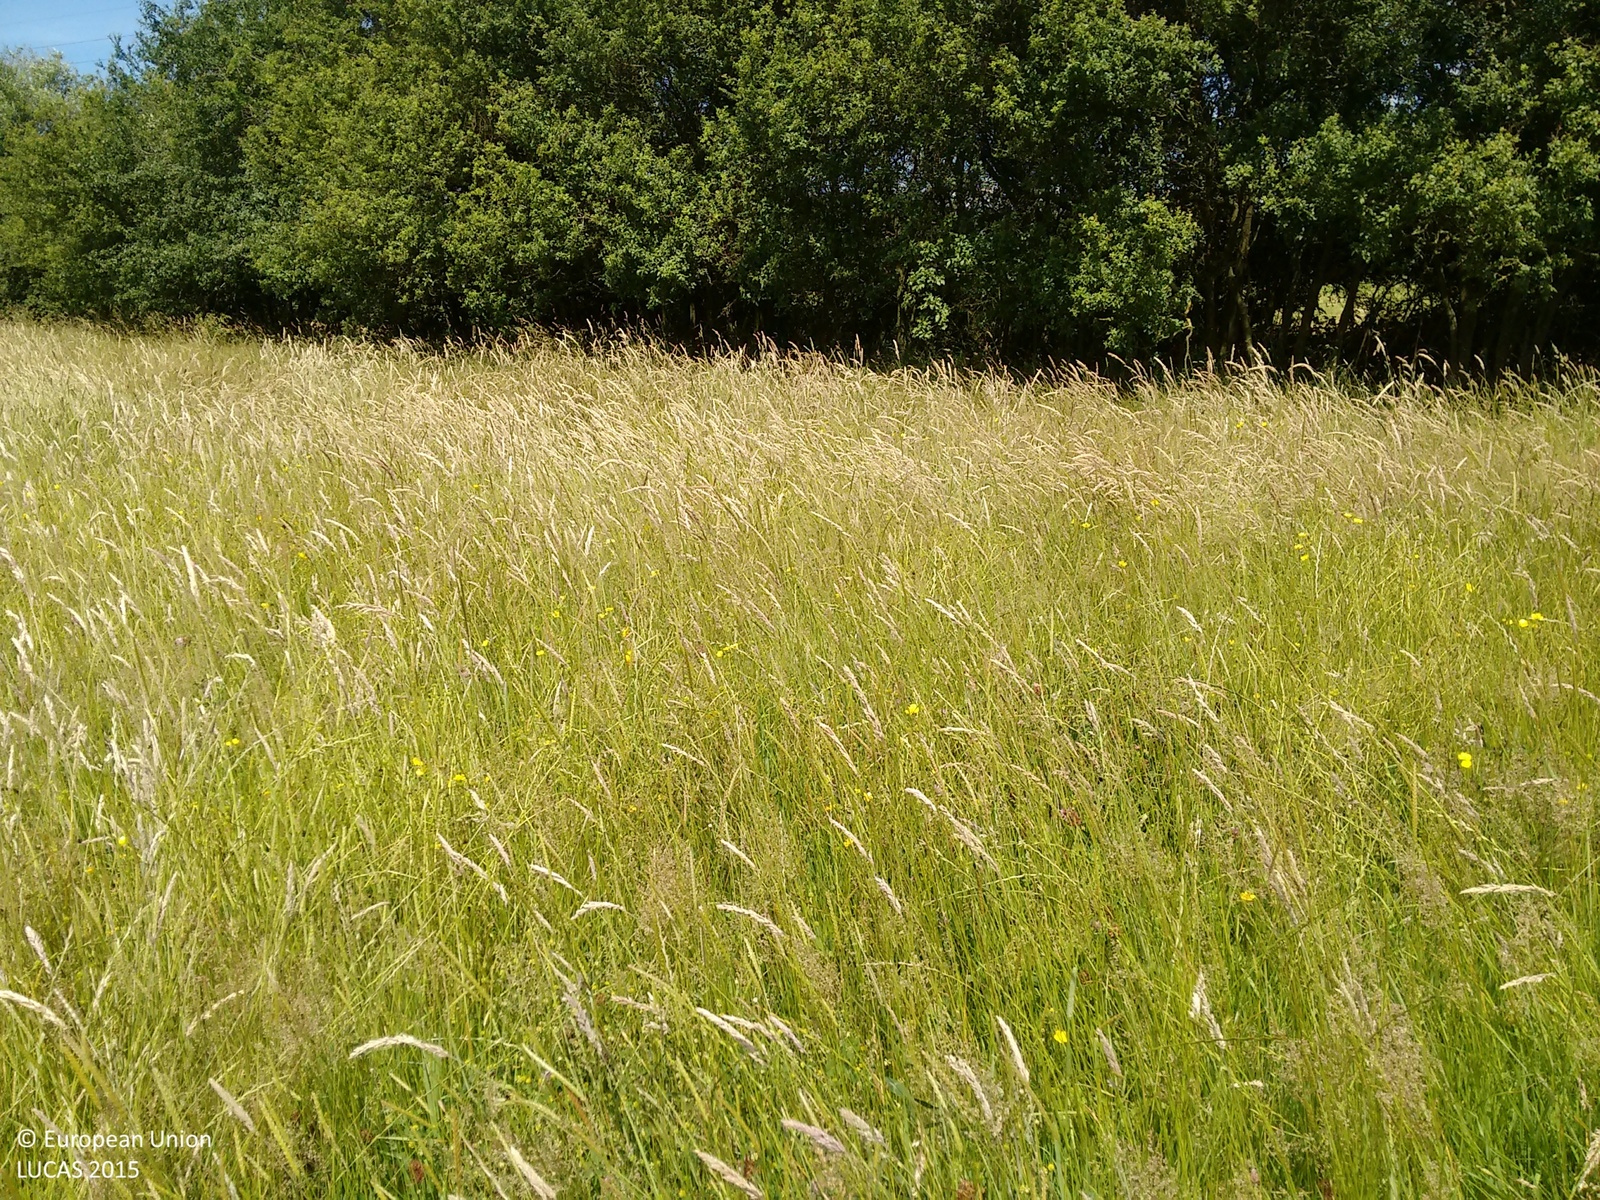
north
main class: Grassland
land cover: Grassland without tree/shrub cover
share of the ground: > 75 %
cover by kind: herbaceous plants 100 %
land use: Agriculture (excluding fallow land and kitchen gardens)
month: July
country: GB
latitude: 52.4417
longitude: -1.4217
